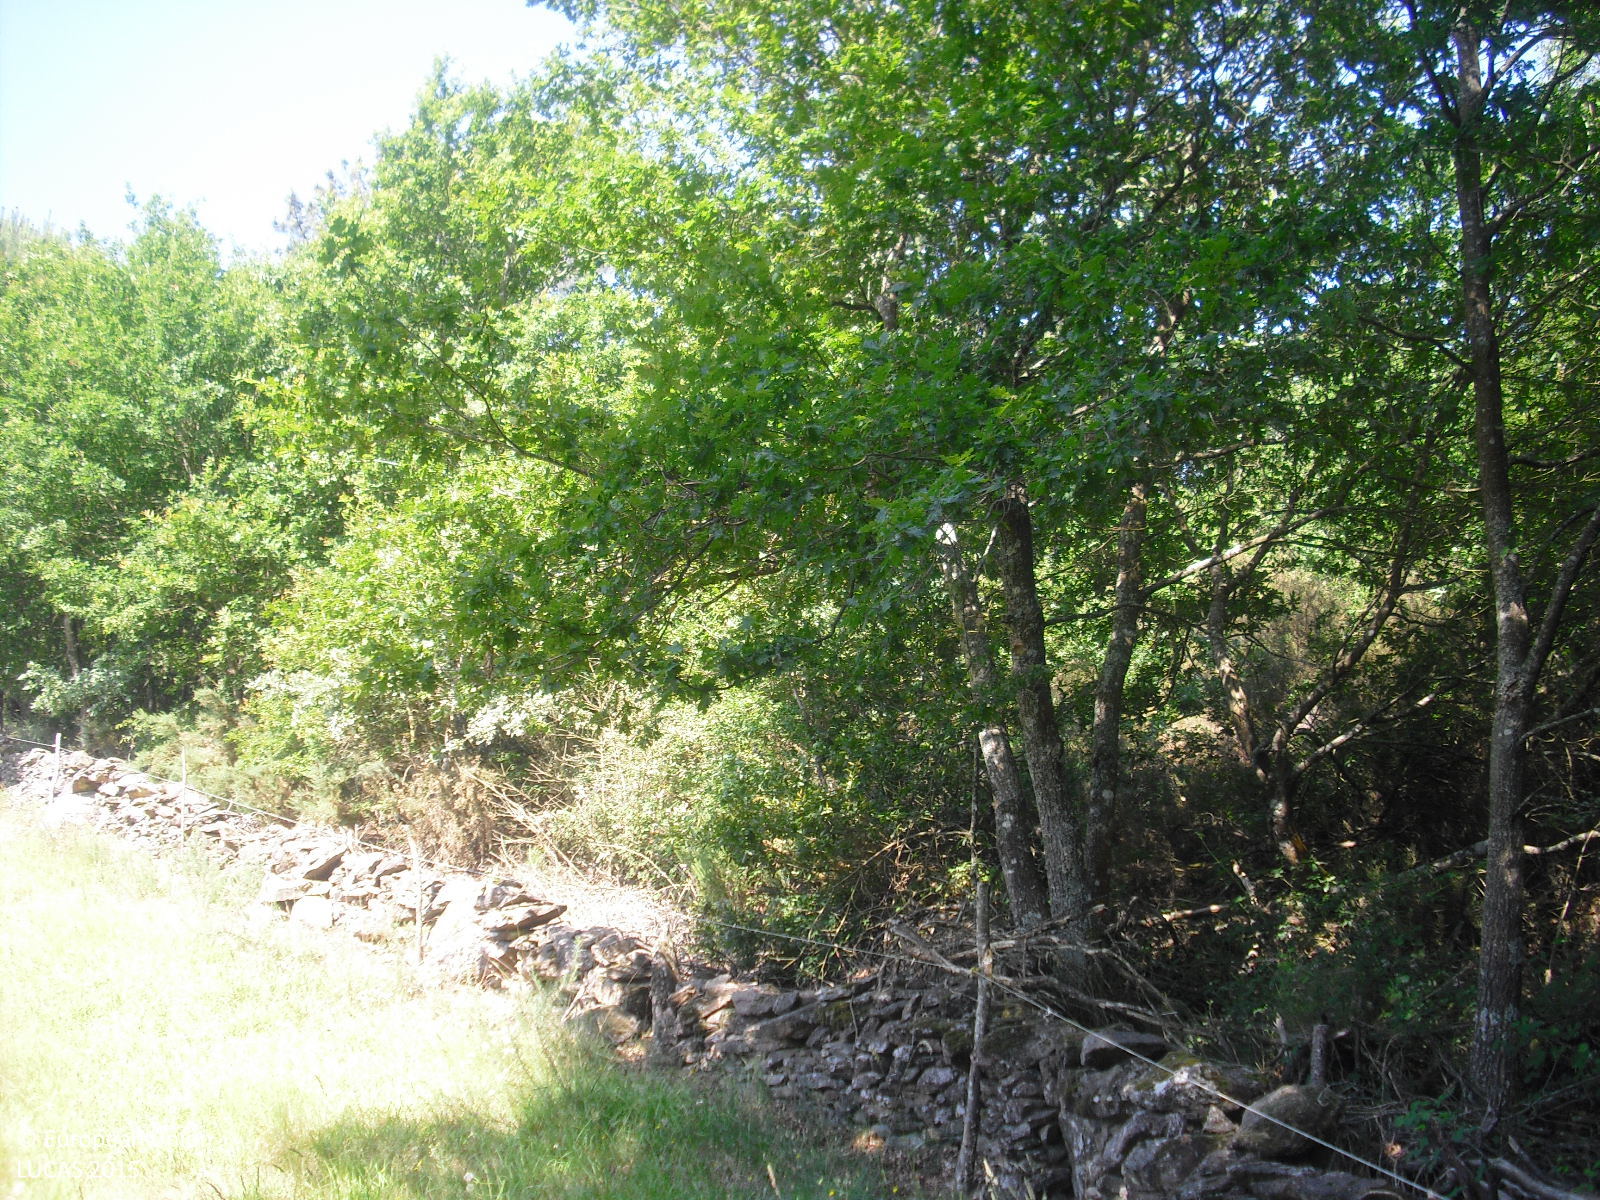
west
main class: Woodland
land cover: Broadleaved woodland
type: acidophilous oak and oak-birch forest
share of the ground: > 75 %
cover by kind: broadleaved forest trees 80 %, coniferous forest trees 20 %
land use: Forestry
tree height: > 5 m
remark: Clear cut
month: June
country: ES
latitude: 42.5784
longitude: -7.7810
